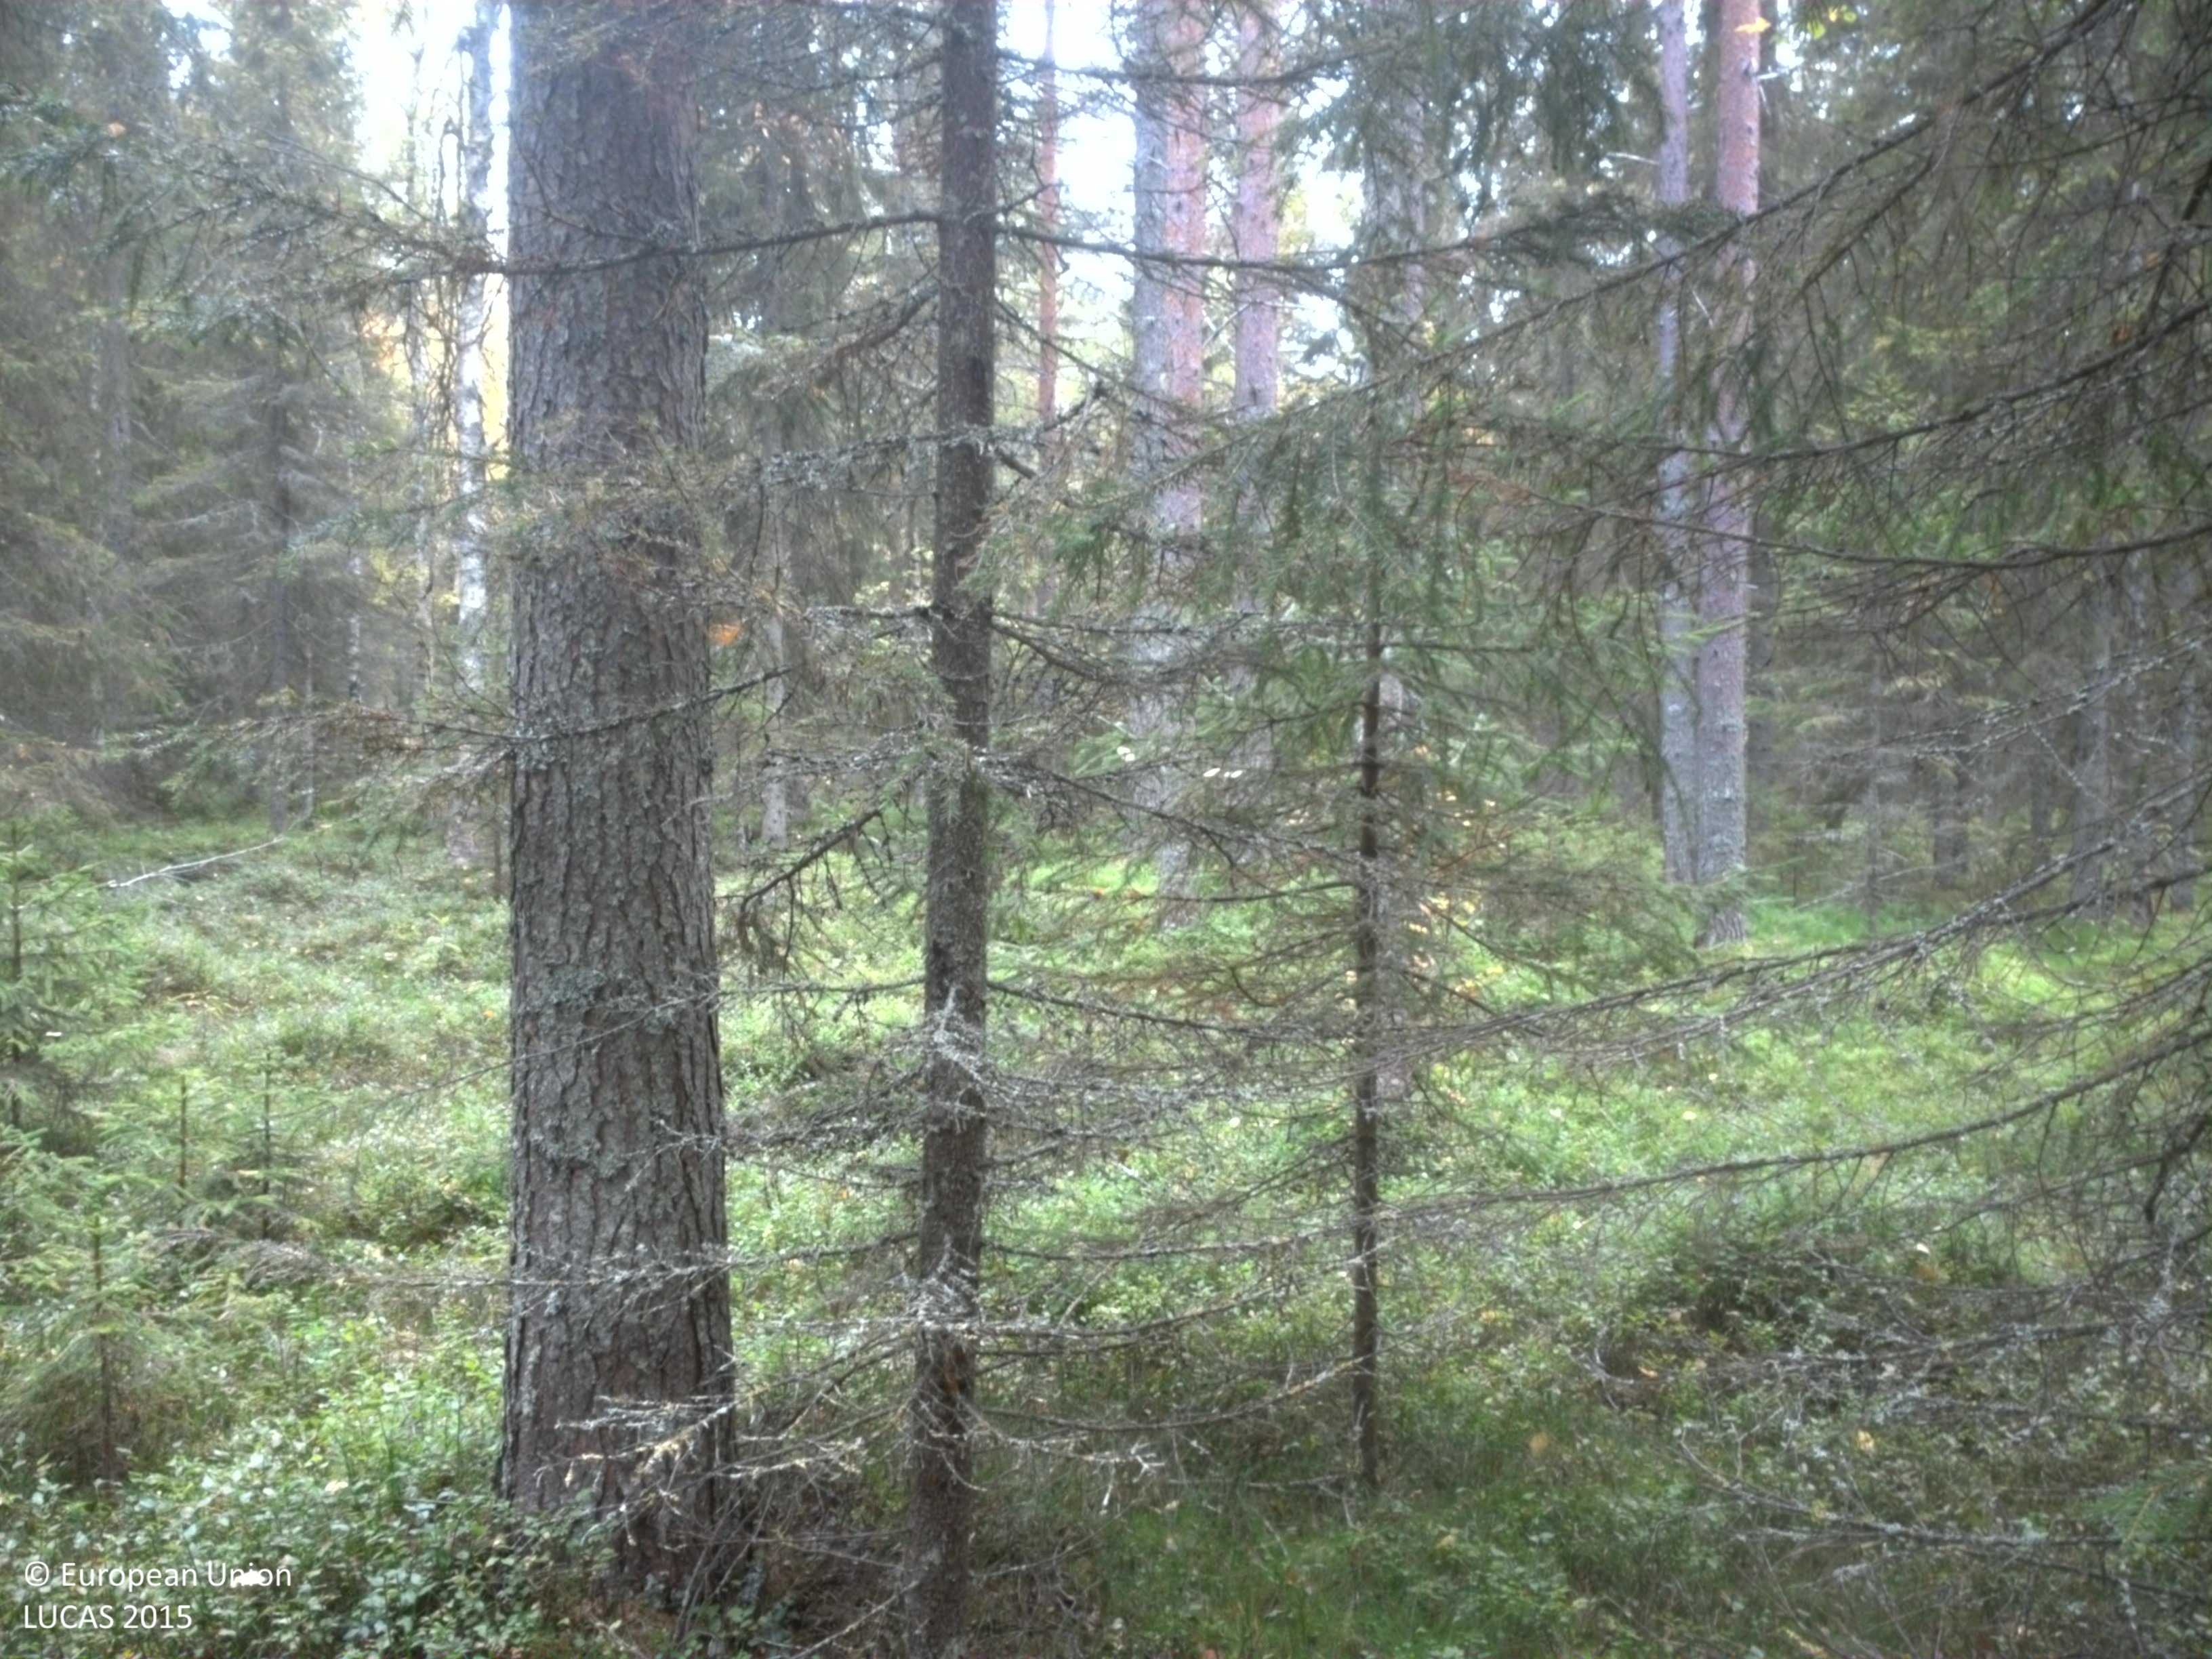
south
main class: Woodland
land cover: Other mixed woodland
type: boreal forest
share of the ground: 50 - 75 %
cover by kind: coniferous forest trees 45 %, shrubs 30 %, broadleaved forest trees 20 %, lichens and mosses 5 %
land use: Forestry
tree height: > 5 m
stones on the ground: 10 - 25 %
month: September
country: SE
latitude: 64.4659
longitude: 20.2683
